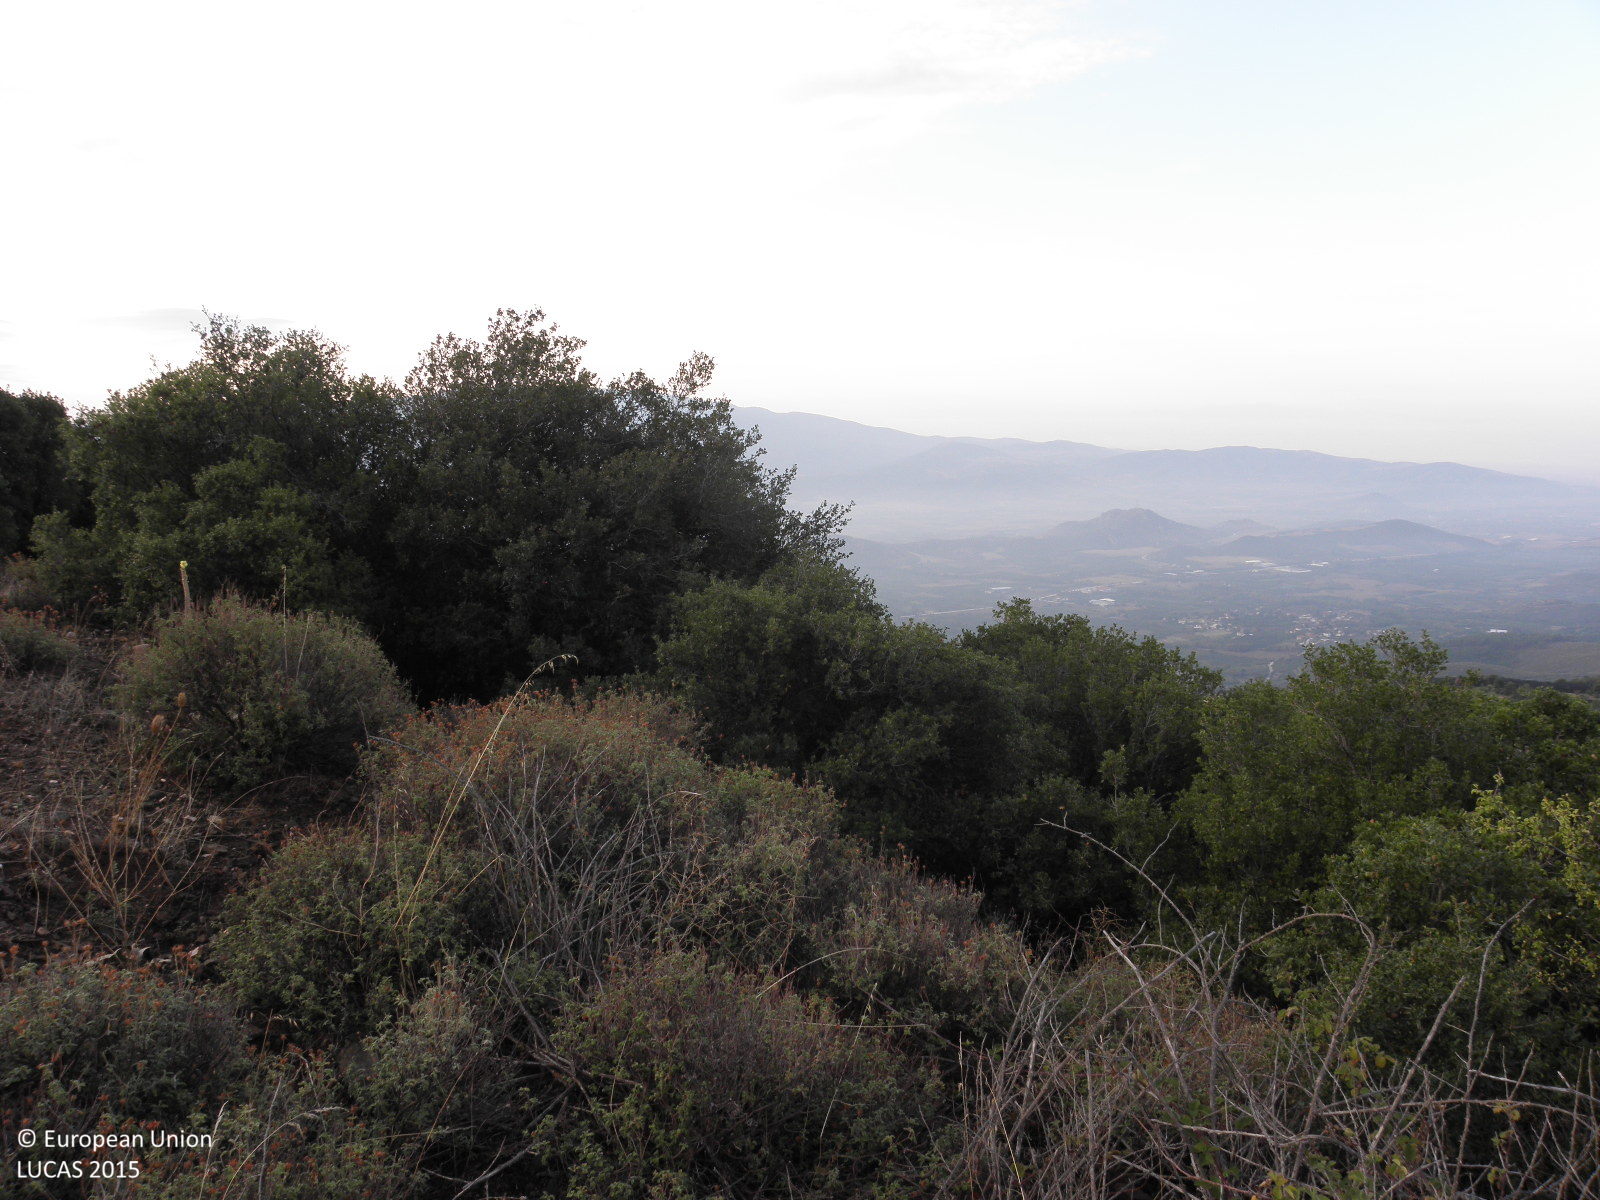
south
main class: Shrubland
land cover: Shrubland with sparse tree cover
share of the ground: > 75 %
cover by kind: shrubs 95 %, broadleaved forest trees 5 %
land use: Semi-natural and natural areas not in use
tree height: > 5 m
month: September
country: GR
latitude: 39.7429
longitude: 22.7492
